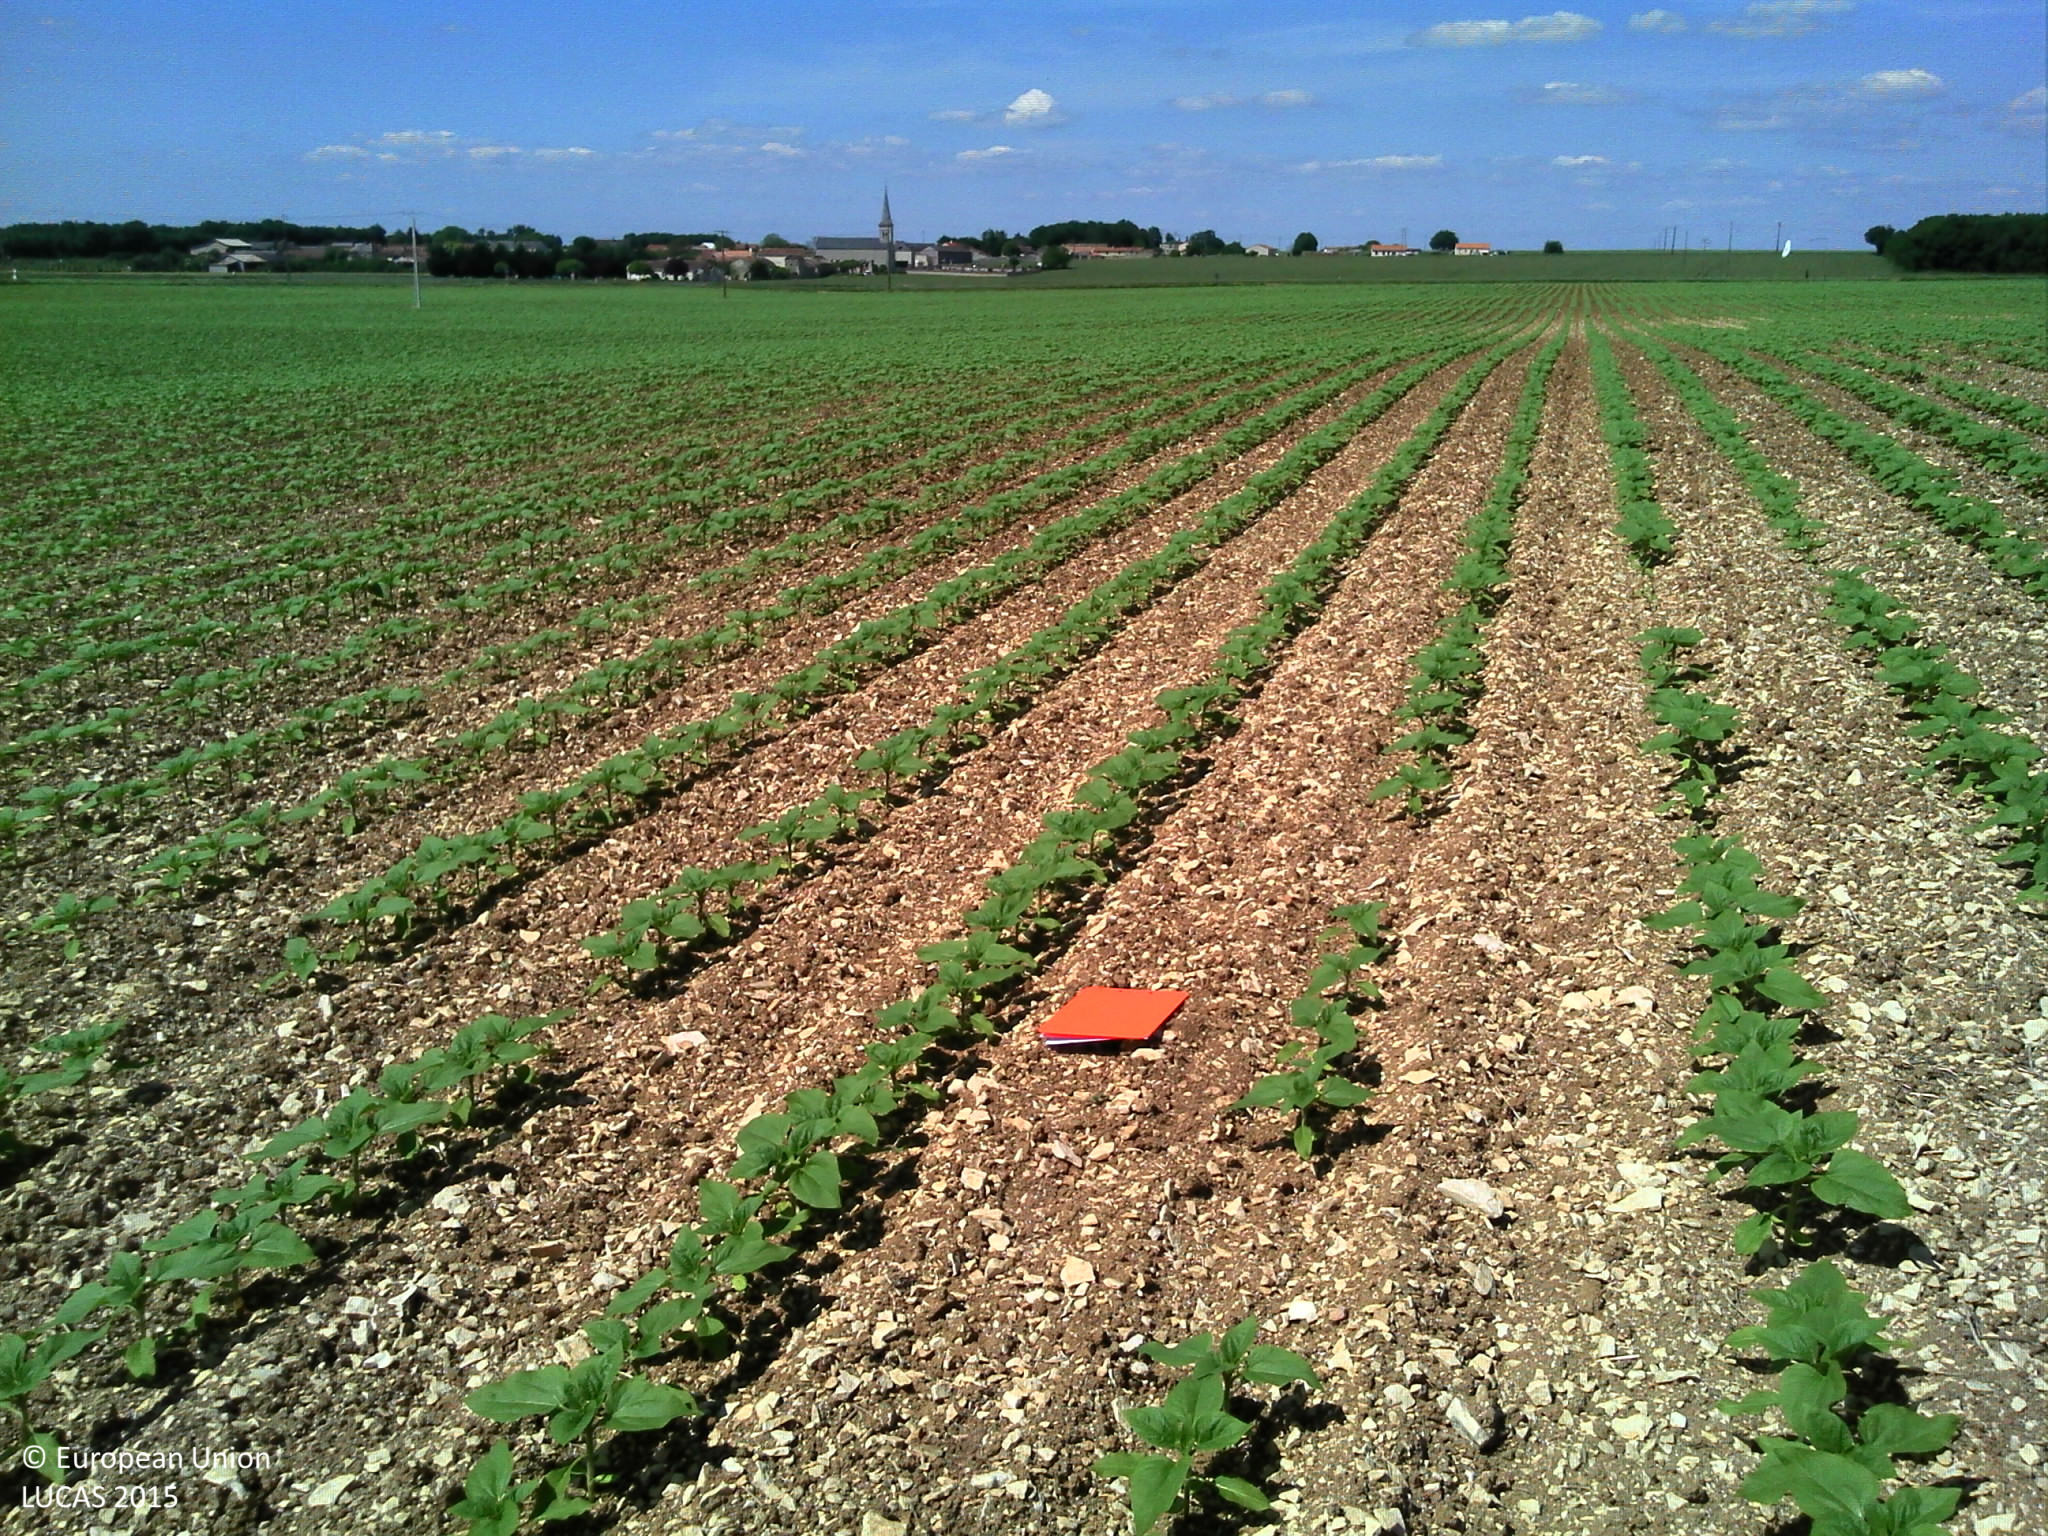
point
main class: Cropland
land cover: Sunflower
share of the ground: 10 - 25 %
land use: Agriculture (excluding fallow land and kitchen gardens)
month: May
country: FR
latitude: 47.0045
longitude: 0.1793
